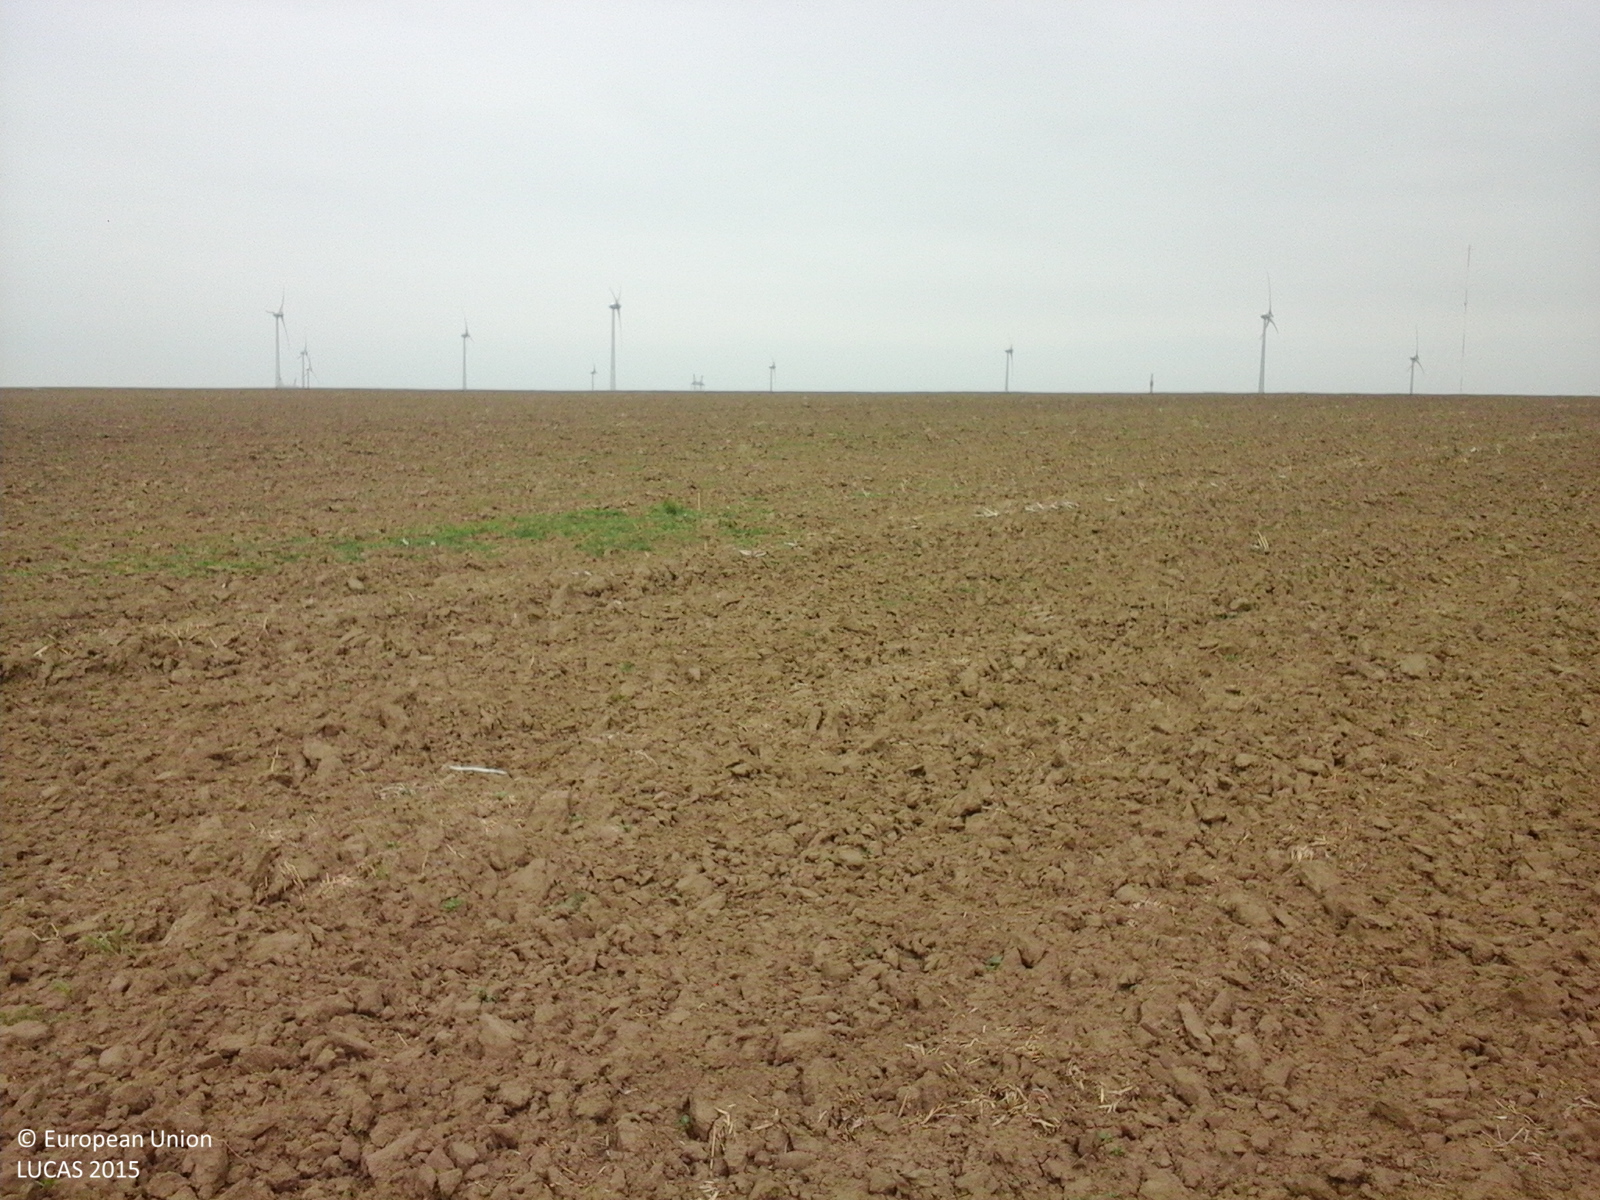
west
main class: Cropland
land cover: Rape and turnip rape
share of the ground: < 10 %
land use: Agriculture (excluding fallow land and kitchen gardens)
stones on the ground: < 10 %
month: August
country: RO
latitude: 44.8162
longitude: 28.2656
